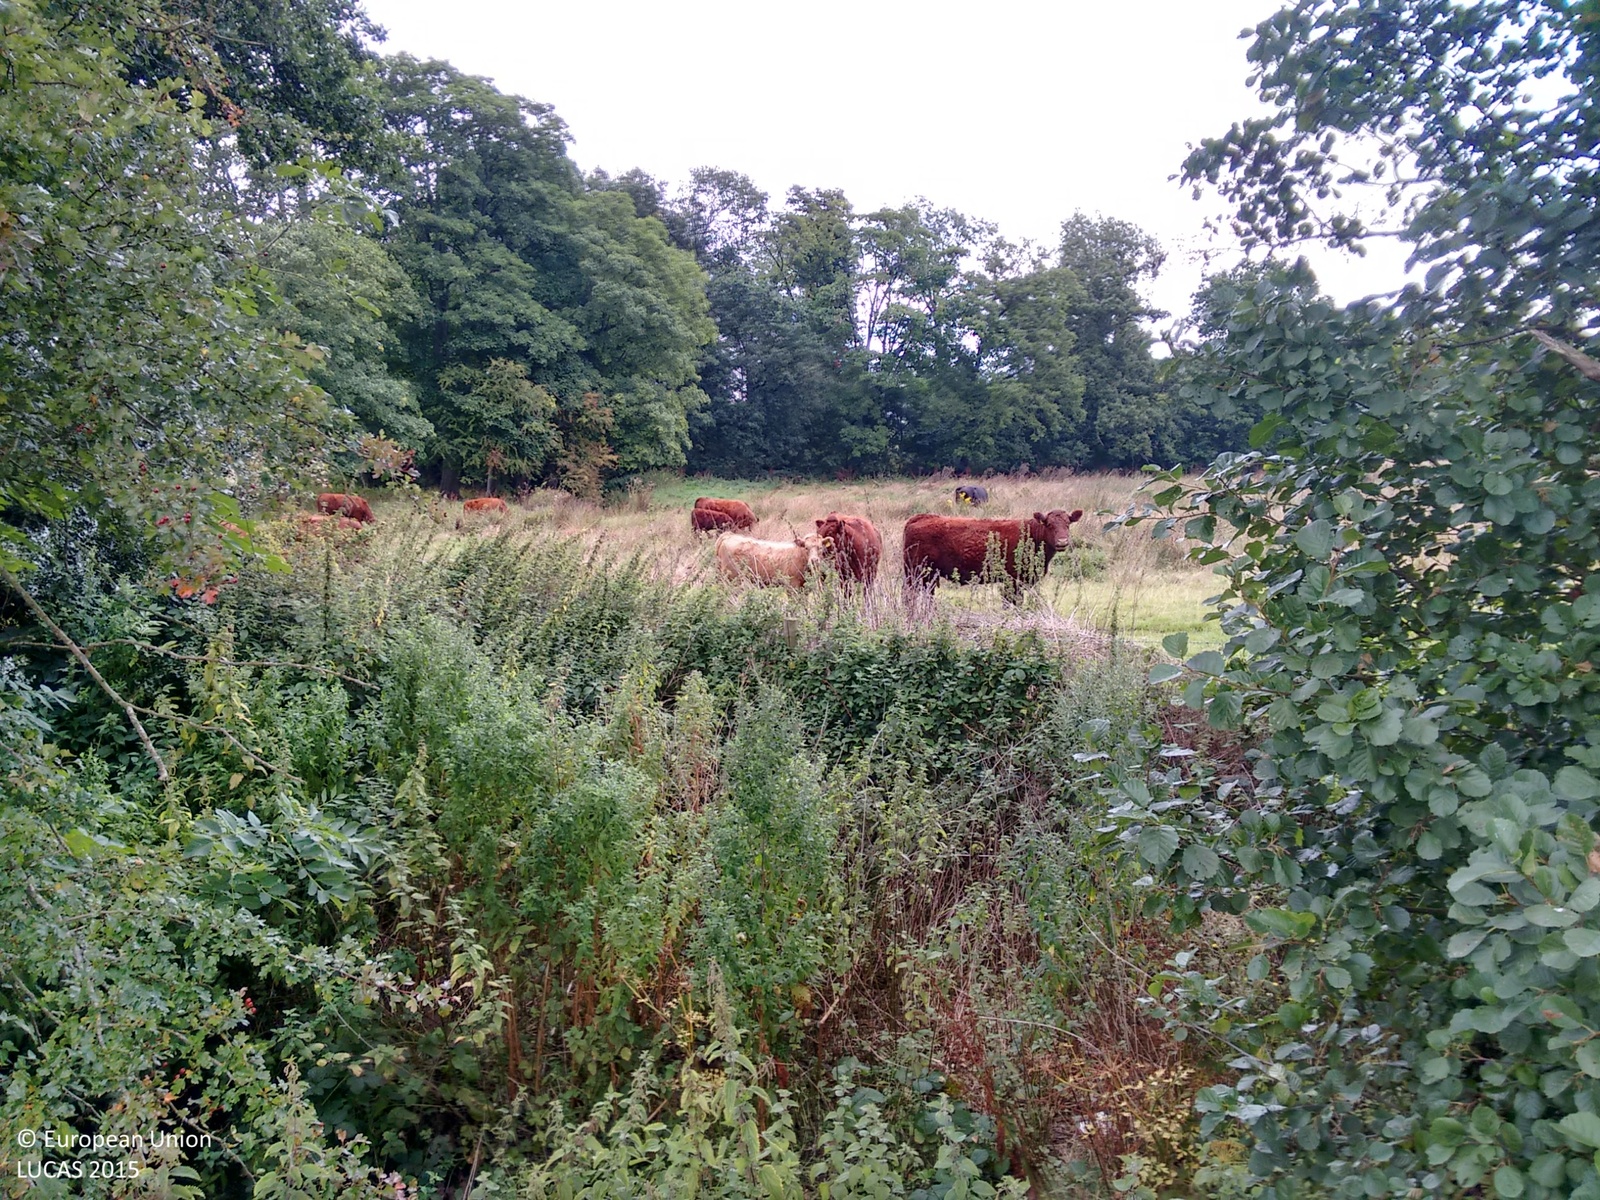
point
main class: Grassland
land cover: Grassland without tree/shrub cover
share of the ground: > 75 %
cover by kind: herbaceous plants 100 %
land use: Agriculture (excluding fallow land and kitchen gardens)
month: September
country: GB
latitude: 52.8953
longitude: -3.0222
